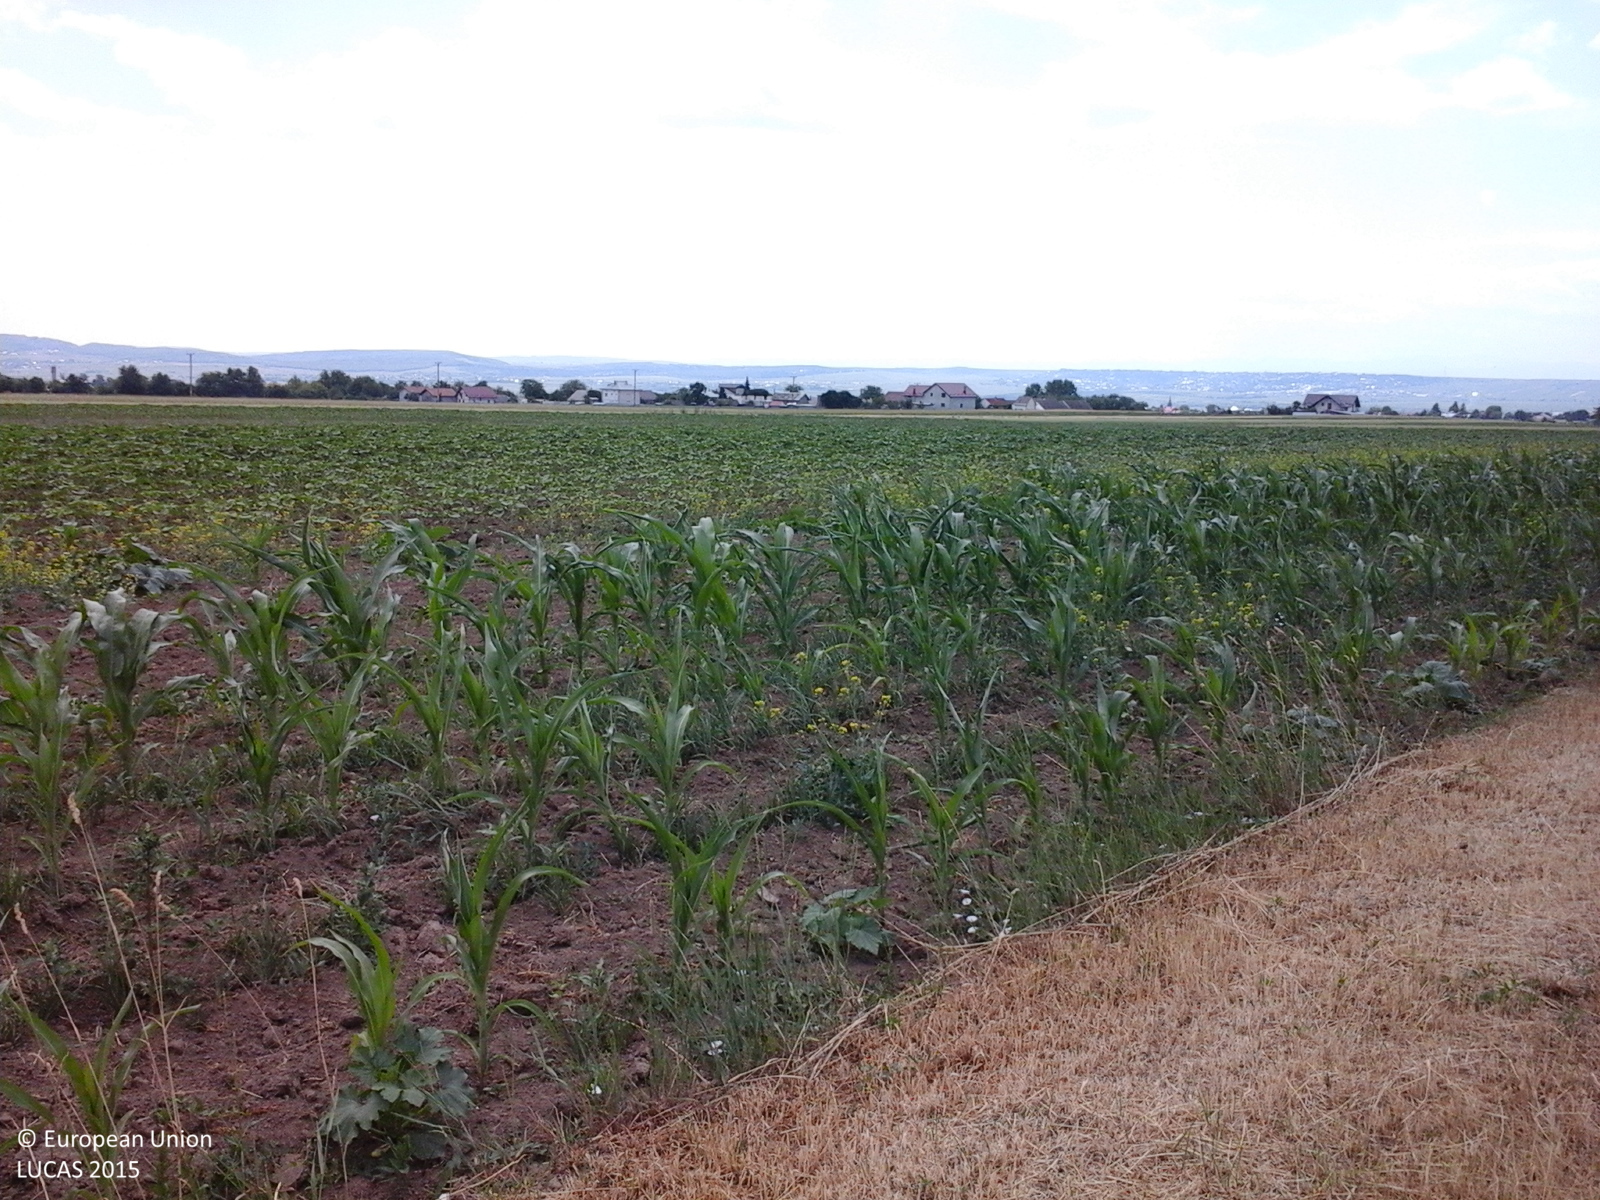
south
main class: Grassland
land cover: Grassland without tree/shrub cover
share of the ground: > 75 %
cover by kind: herbaceous plants 100 %
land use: Agriculture (excluding fallow land and kitchen gardens)
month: June
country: RO
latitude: 47.6675
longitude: 26.3738
